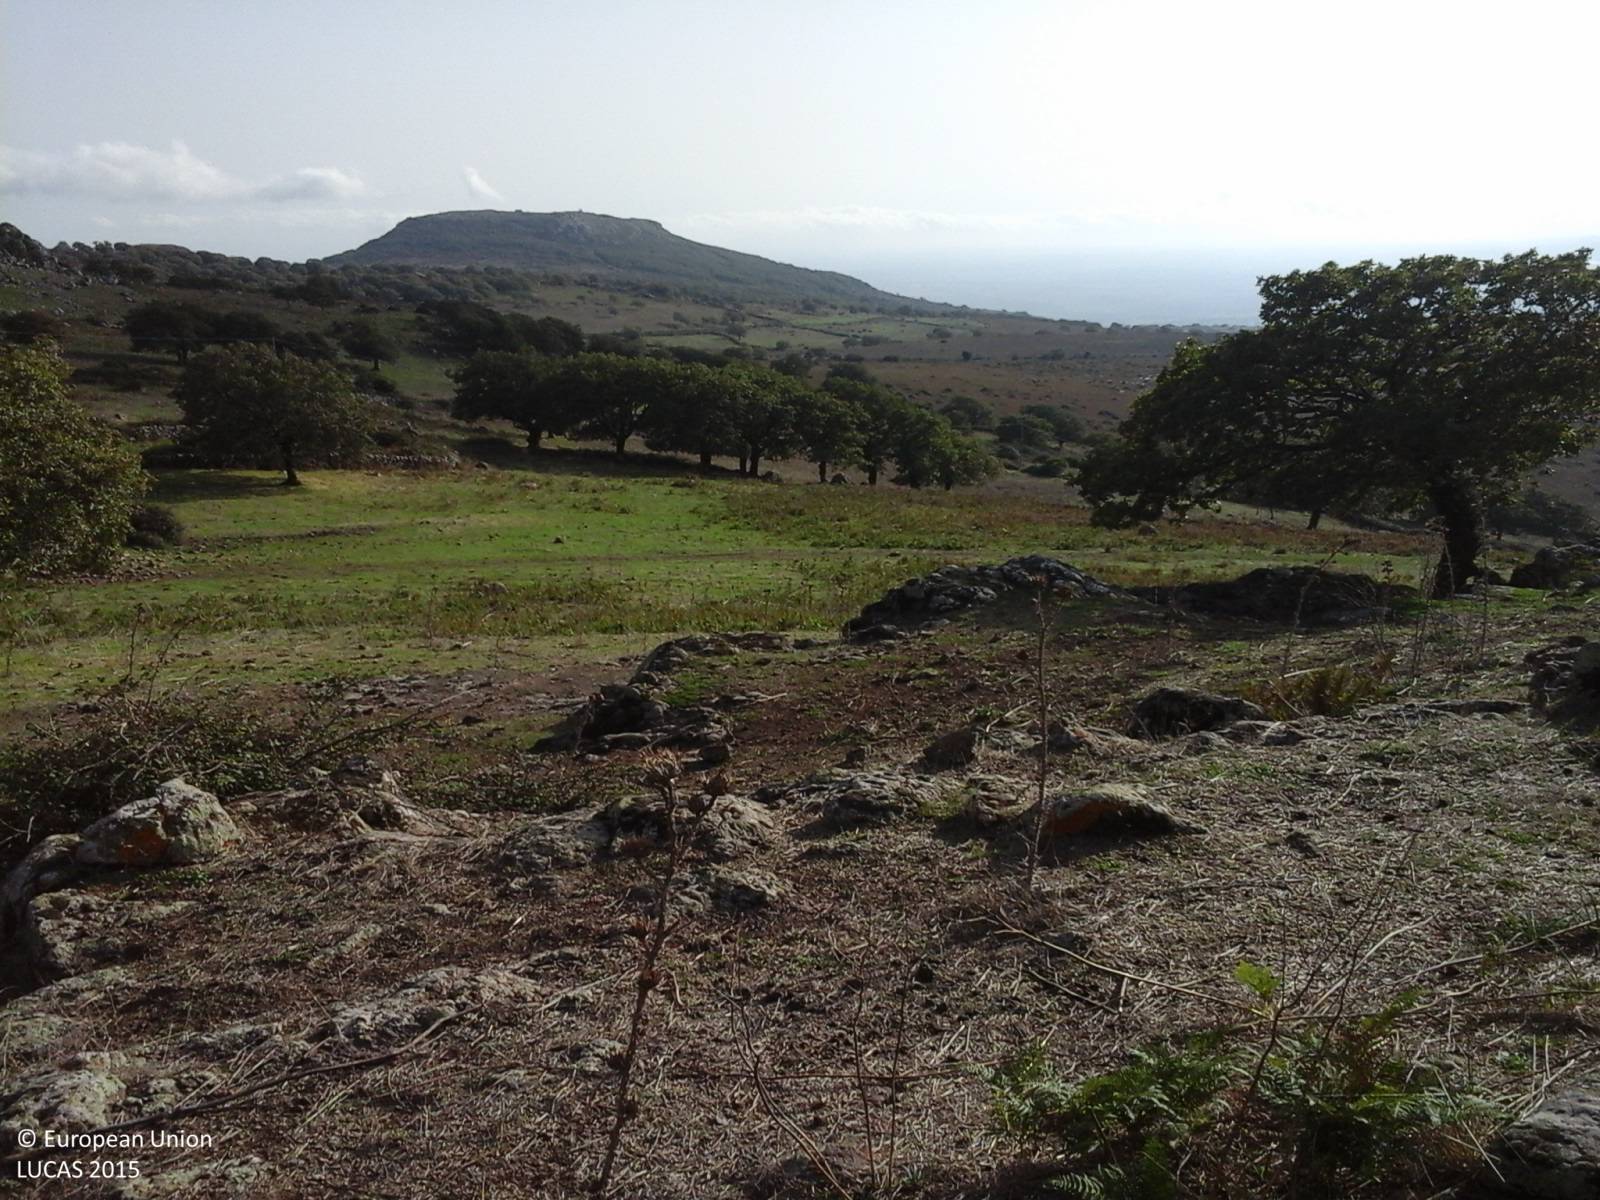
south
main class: Grassland
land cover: Grassland without tree/shrub cover
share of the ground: > 75 %
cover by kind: herbaceous plants 90 %, consolidated bare surface 10 %
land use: Agriculture (excluding fallow land and kitchen gardens)
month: October
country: IT
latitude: 40.3148
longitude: 8.8410
